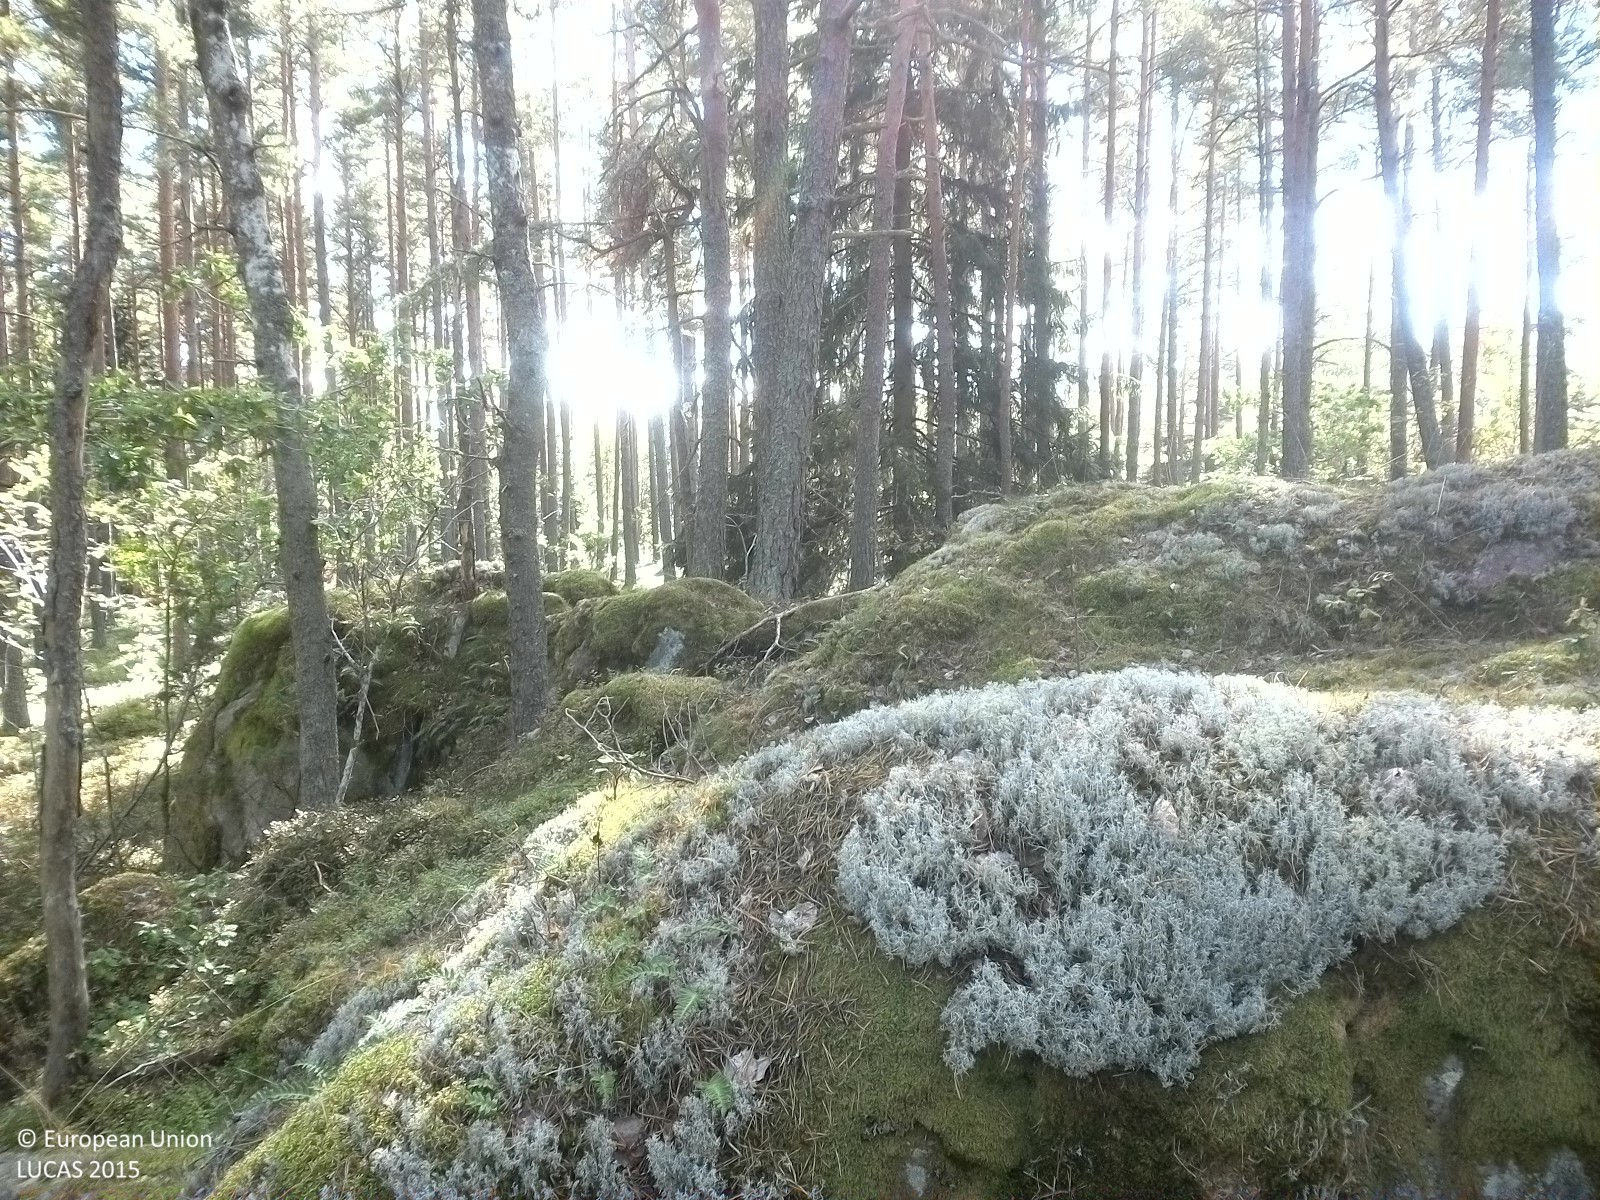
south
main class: Woodland
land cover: Pine dominated coniferous woodland
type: boreal forest
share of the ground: 25 - 50 %
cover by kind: herbaceous plants 55 %, coniferous forest trees 25 %, lichens and mosses 15 %, broadleaved forest trees 5 %
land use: Forestry
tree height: > 5 m
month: September
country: SE
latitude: 58.5232
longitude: 16.2971
